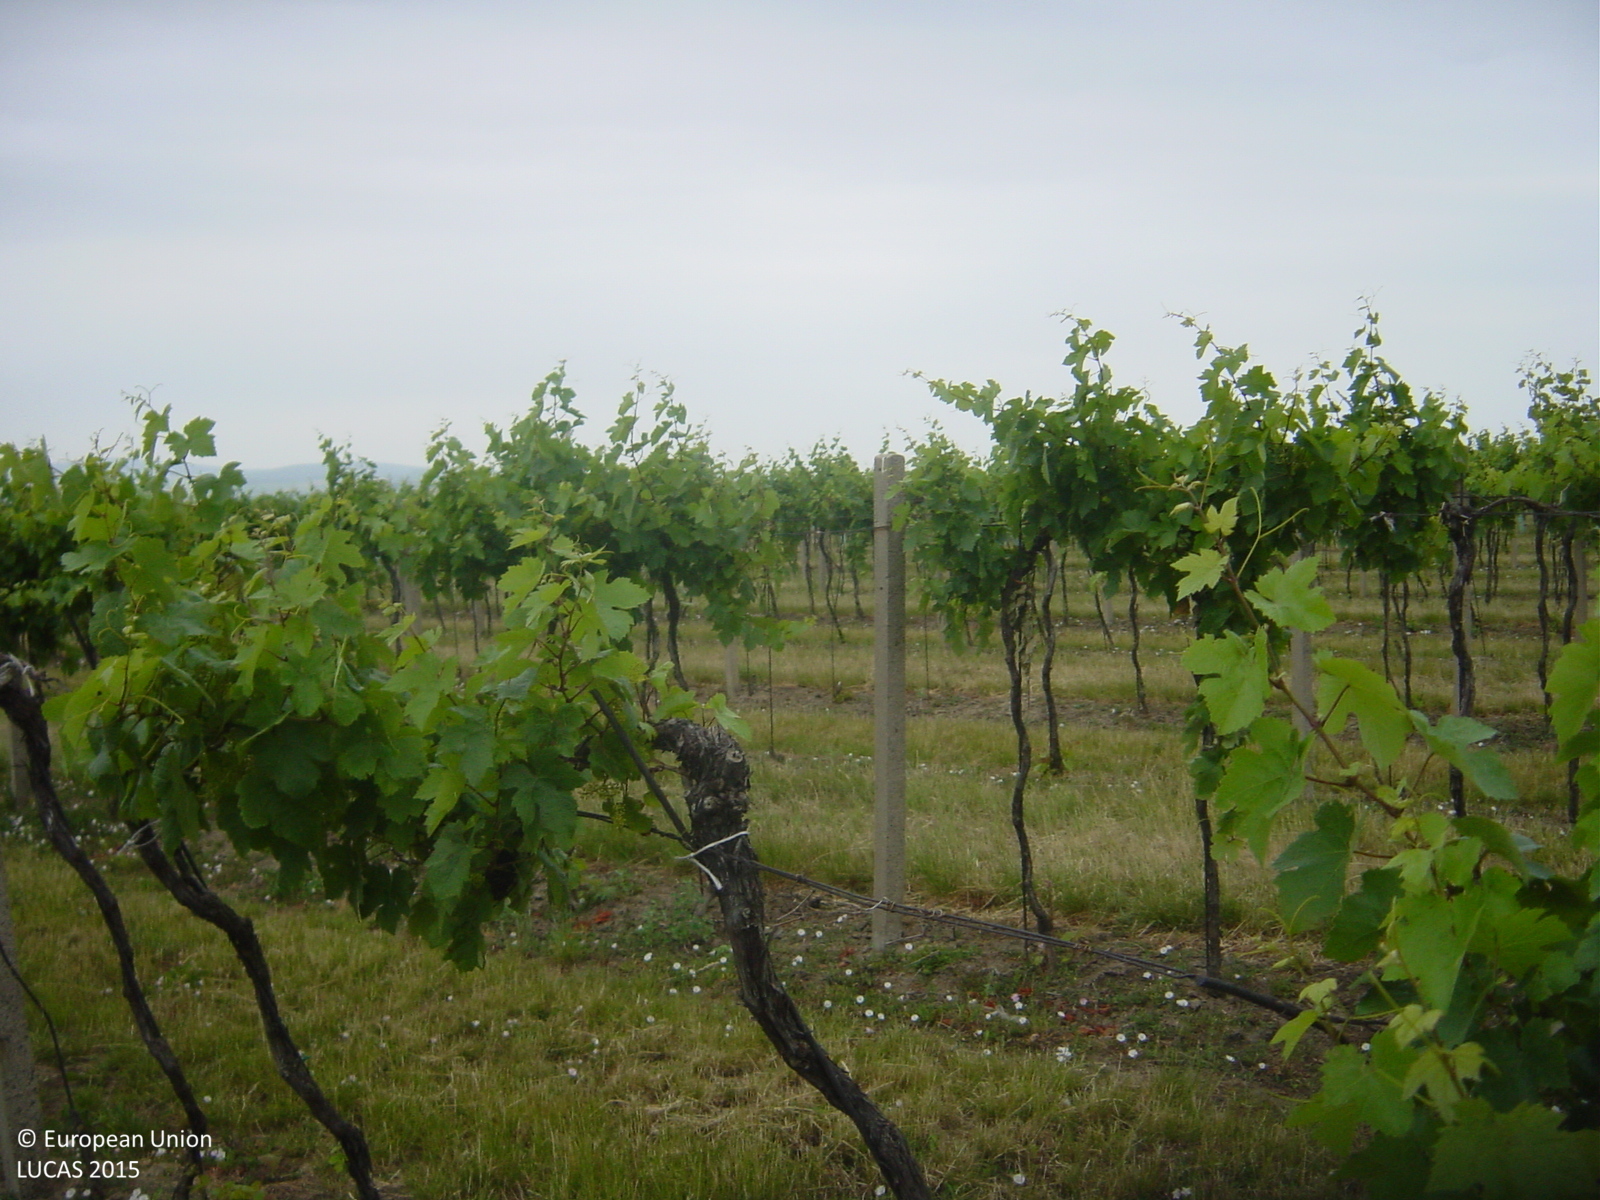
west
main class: Cropland
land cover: Vineyards
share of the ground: 10 - 25 %
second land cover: Grassland without tree/shrub cover
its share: > 75 %
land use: Agriculture (excluding fallow land and kitchen gardens)
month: June
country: CZ
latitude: 48.9605
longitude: 16.9606
